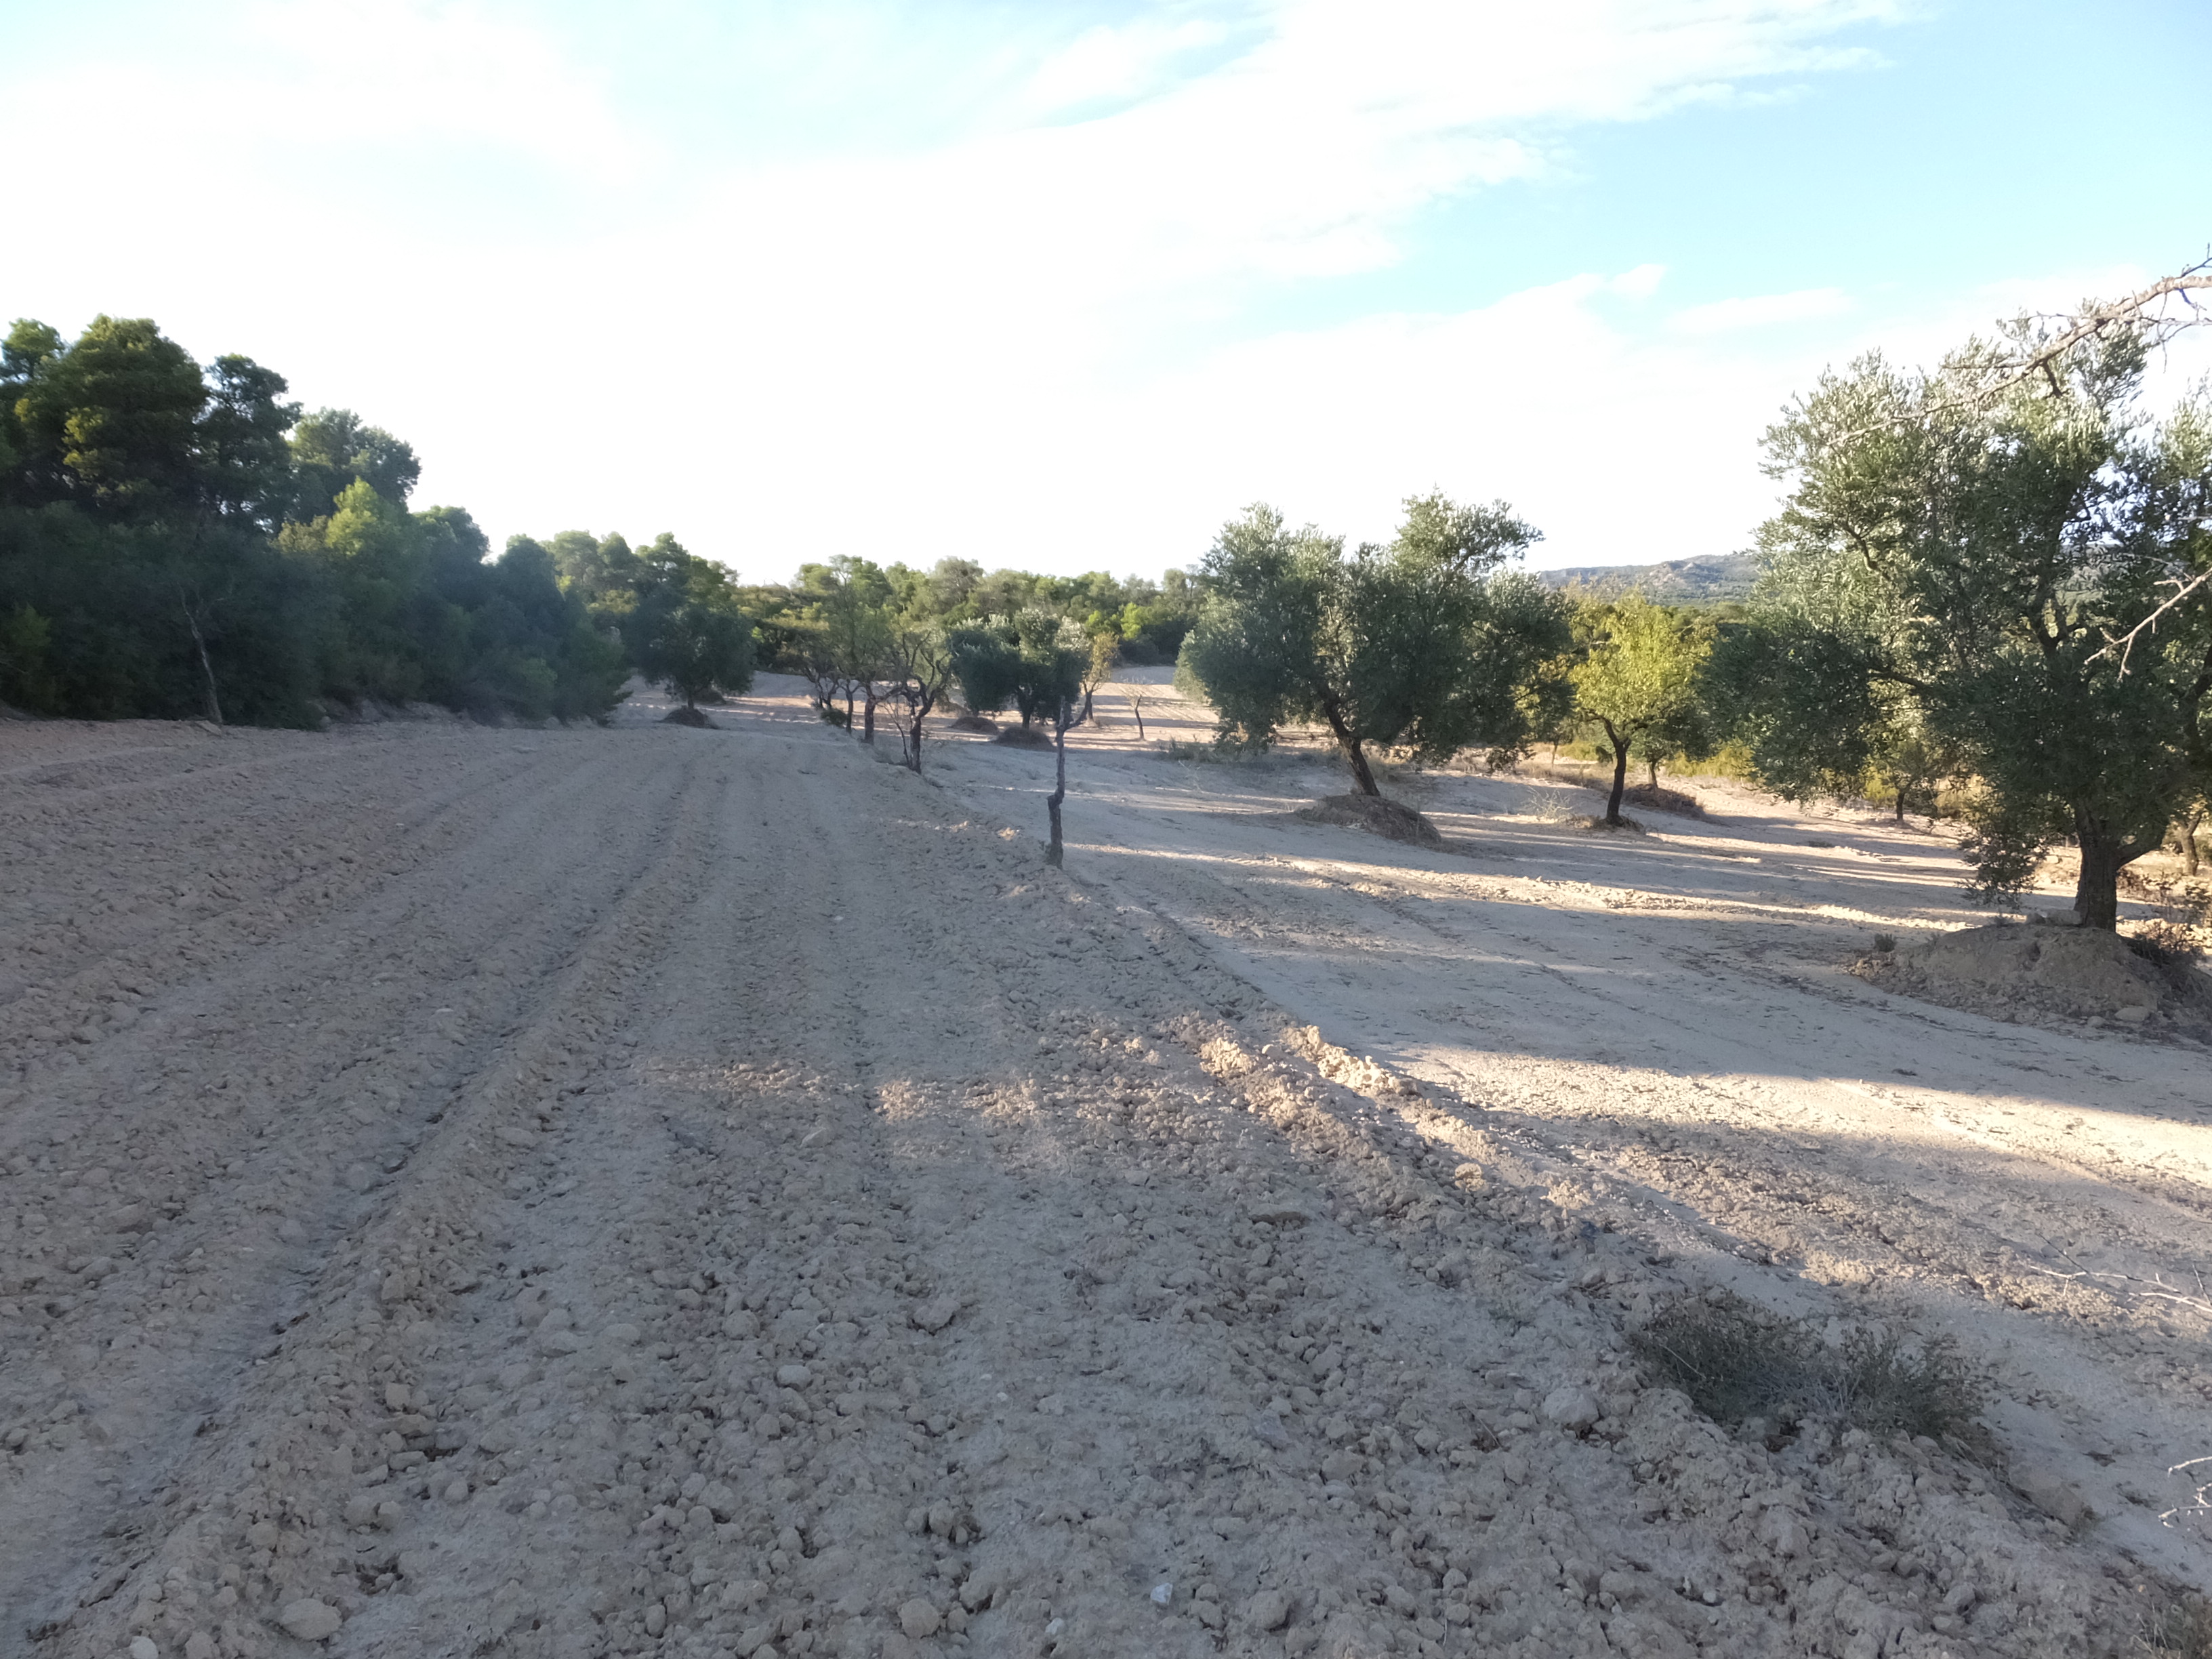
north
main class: Cropland
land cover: Nuts trees
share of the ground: 50 - 75 %
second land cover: Olive groves
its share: 25 - 50 %
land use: Agriculture (excluding fallow land and kitchen gardens)
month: August
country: ES
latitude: 41.2672
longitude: 0.1883
